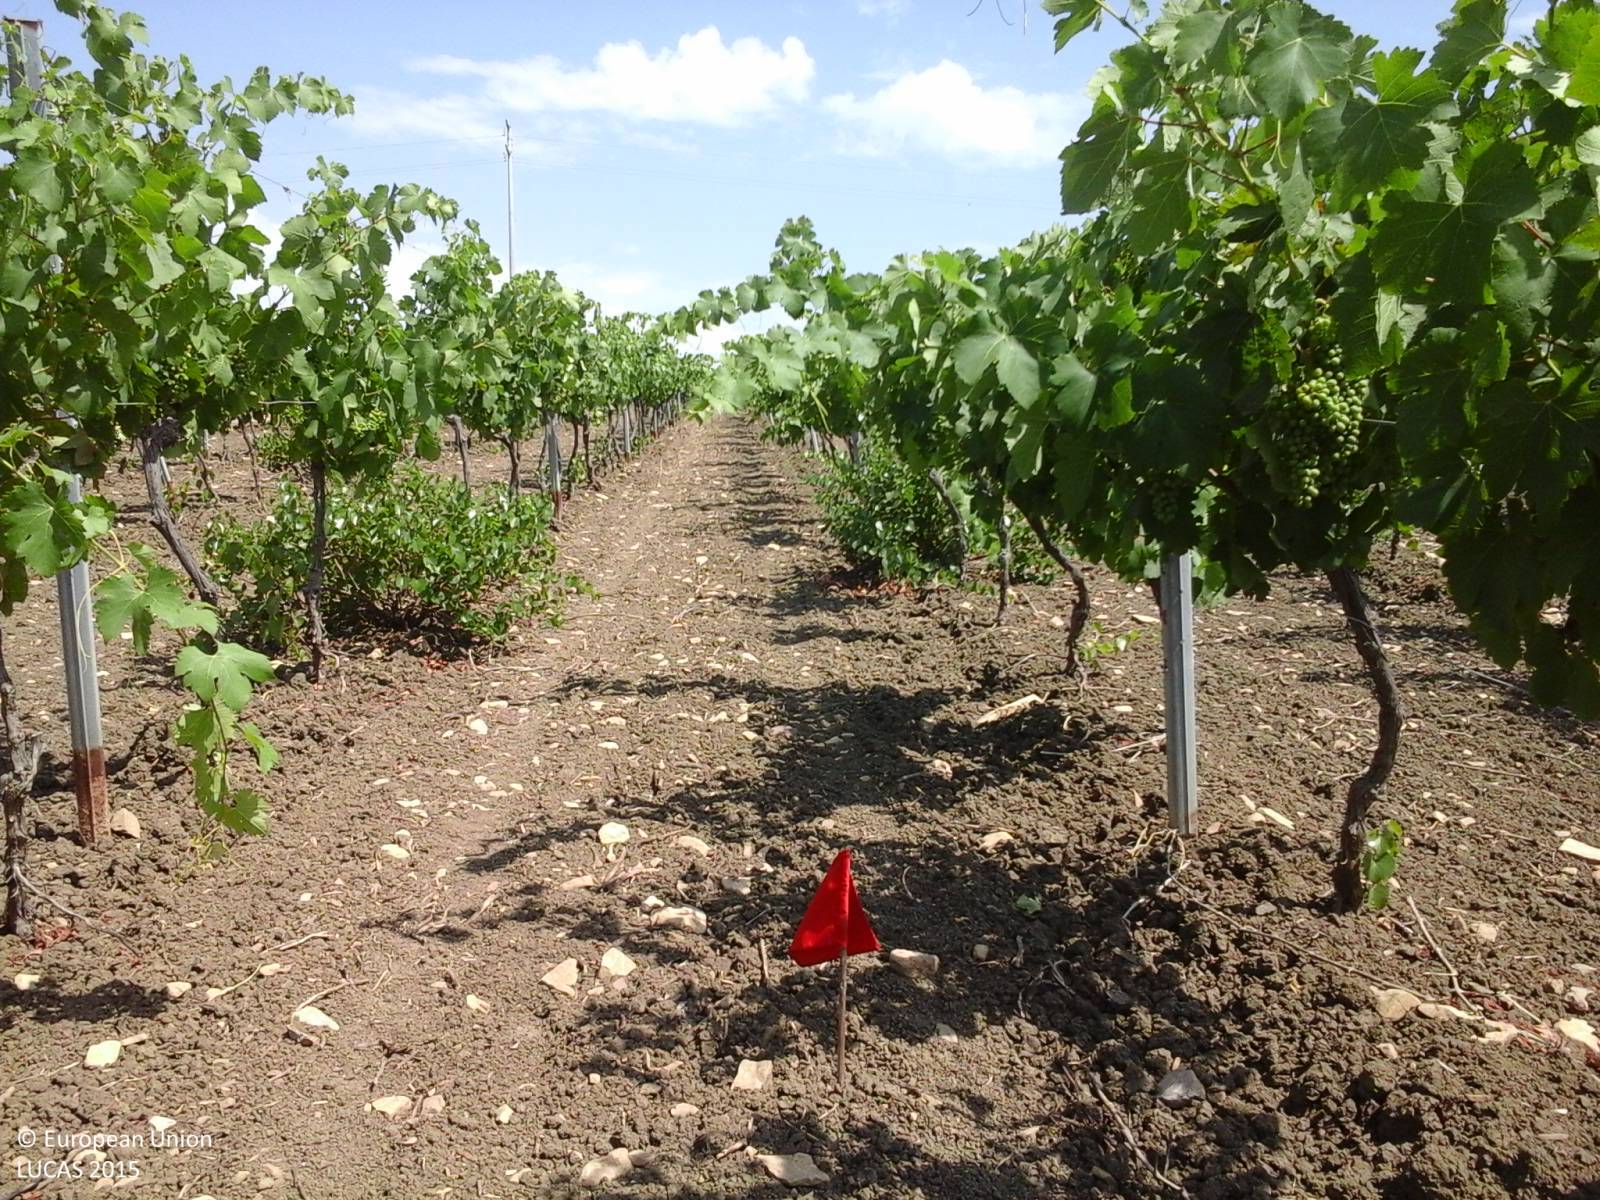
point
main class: Cropland
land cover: Vineyards
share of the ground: 50 - 75 %
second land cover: Other bare soil
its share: > 75 %
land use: Agriculture (excluding fallow land and kitchen gardens)
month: June
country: IT
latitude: 37.8734
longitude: 12.6746
